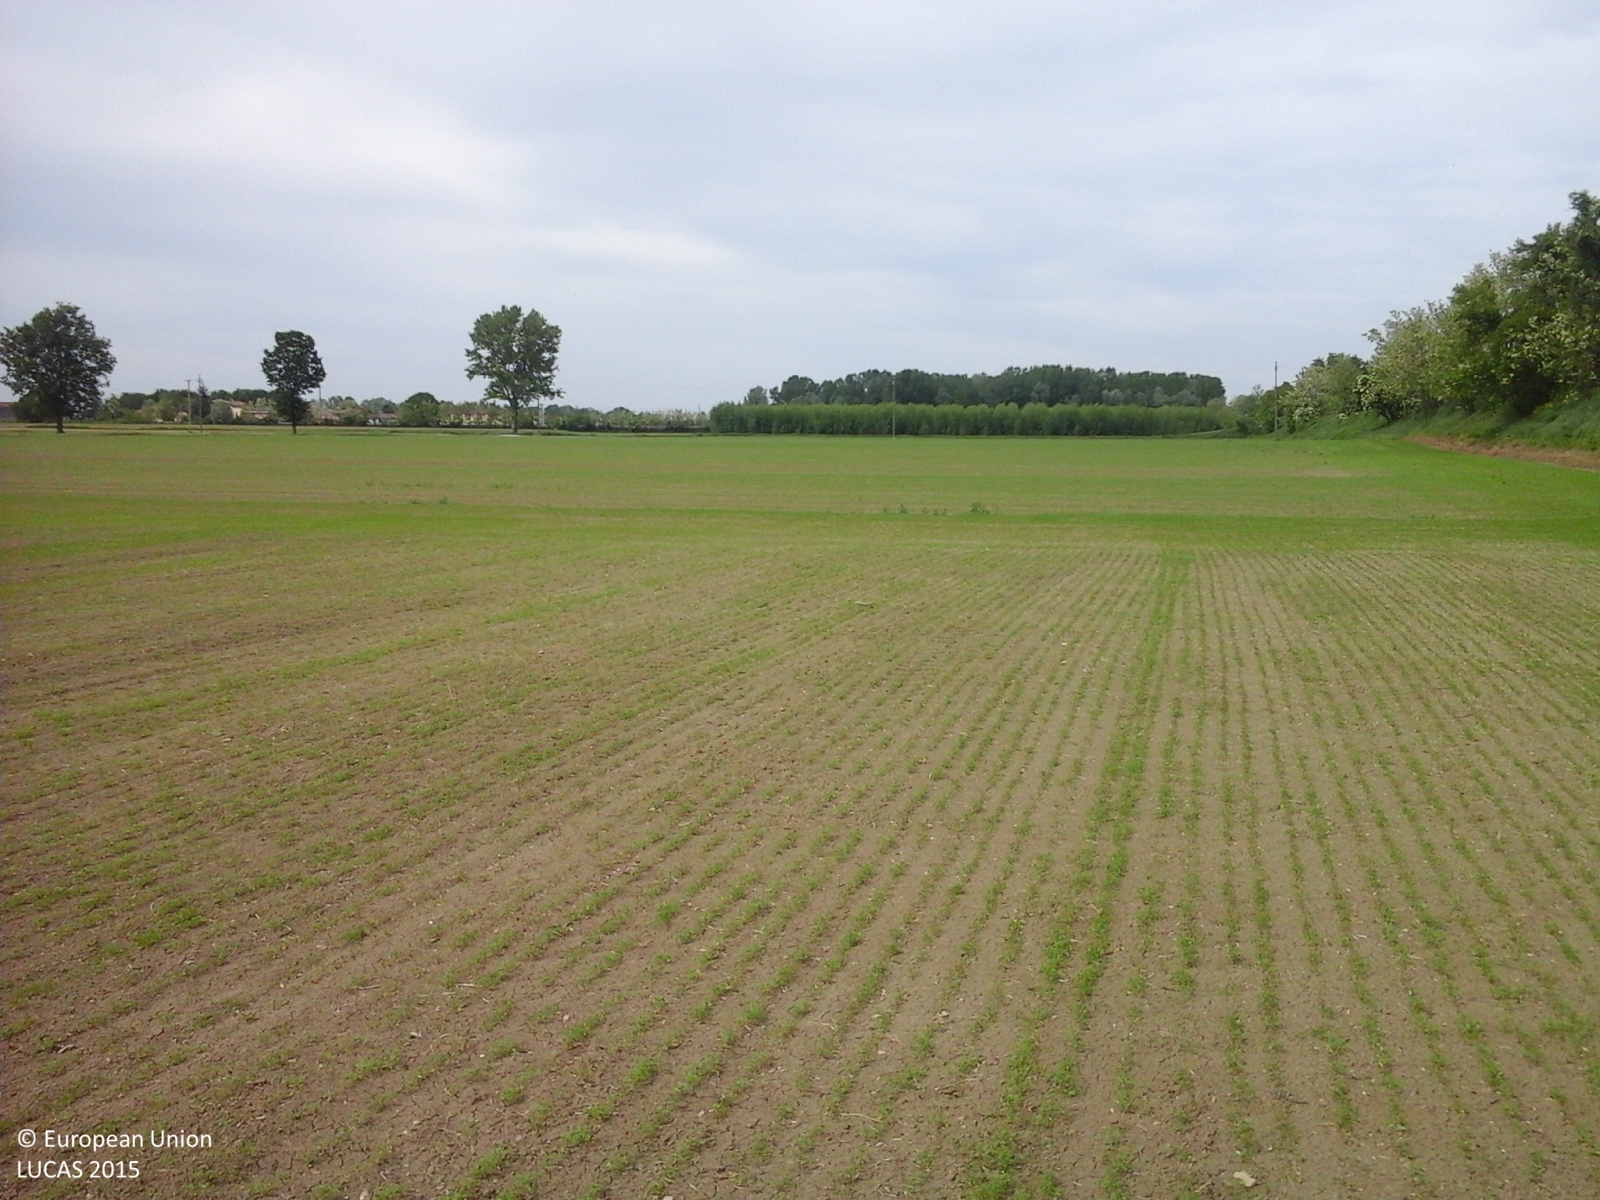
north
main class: Cropland
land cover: Lucerne
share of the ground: < 10 %
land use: Agriculture (excluding fallow land and kitchen gardens)
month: May
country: IT
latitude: 45.0686
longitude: 9.1760
